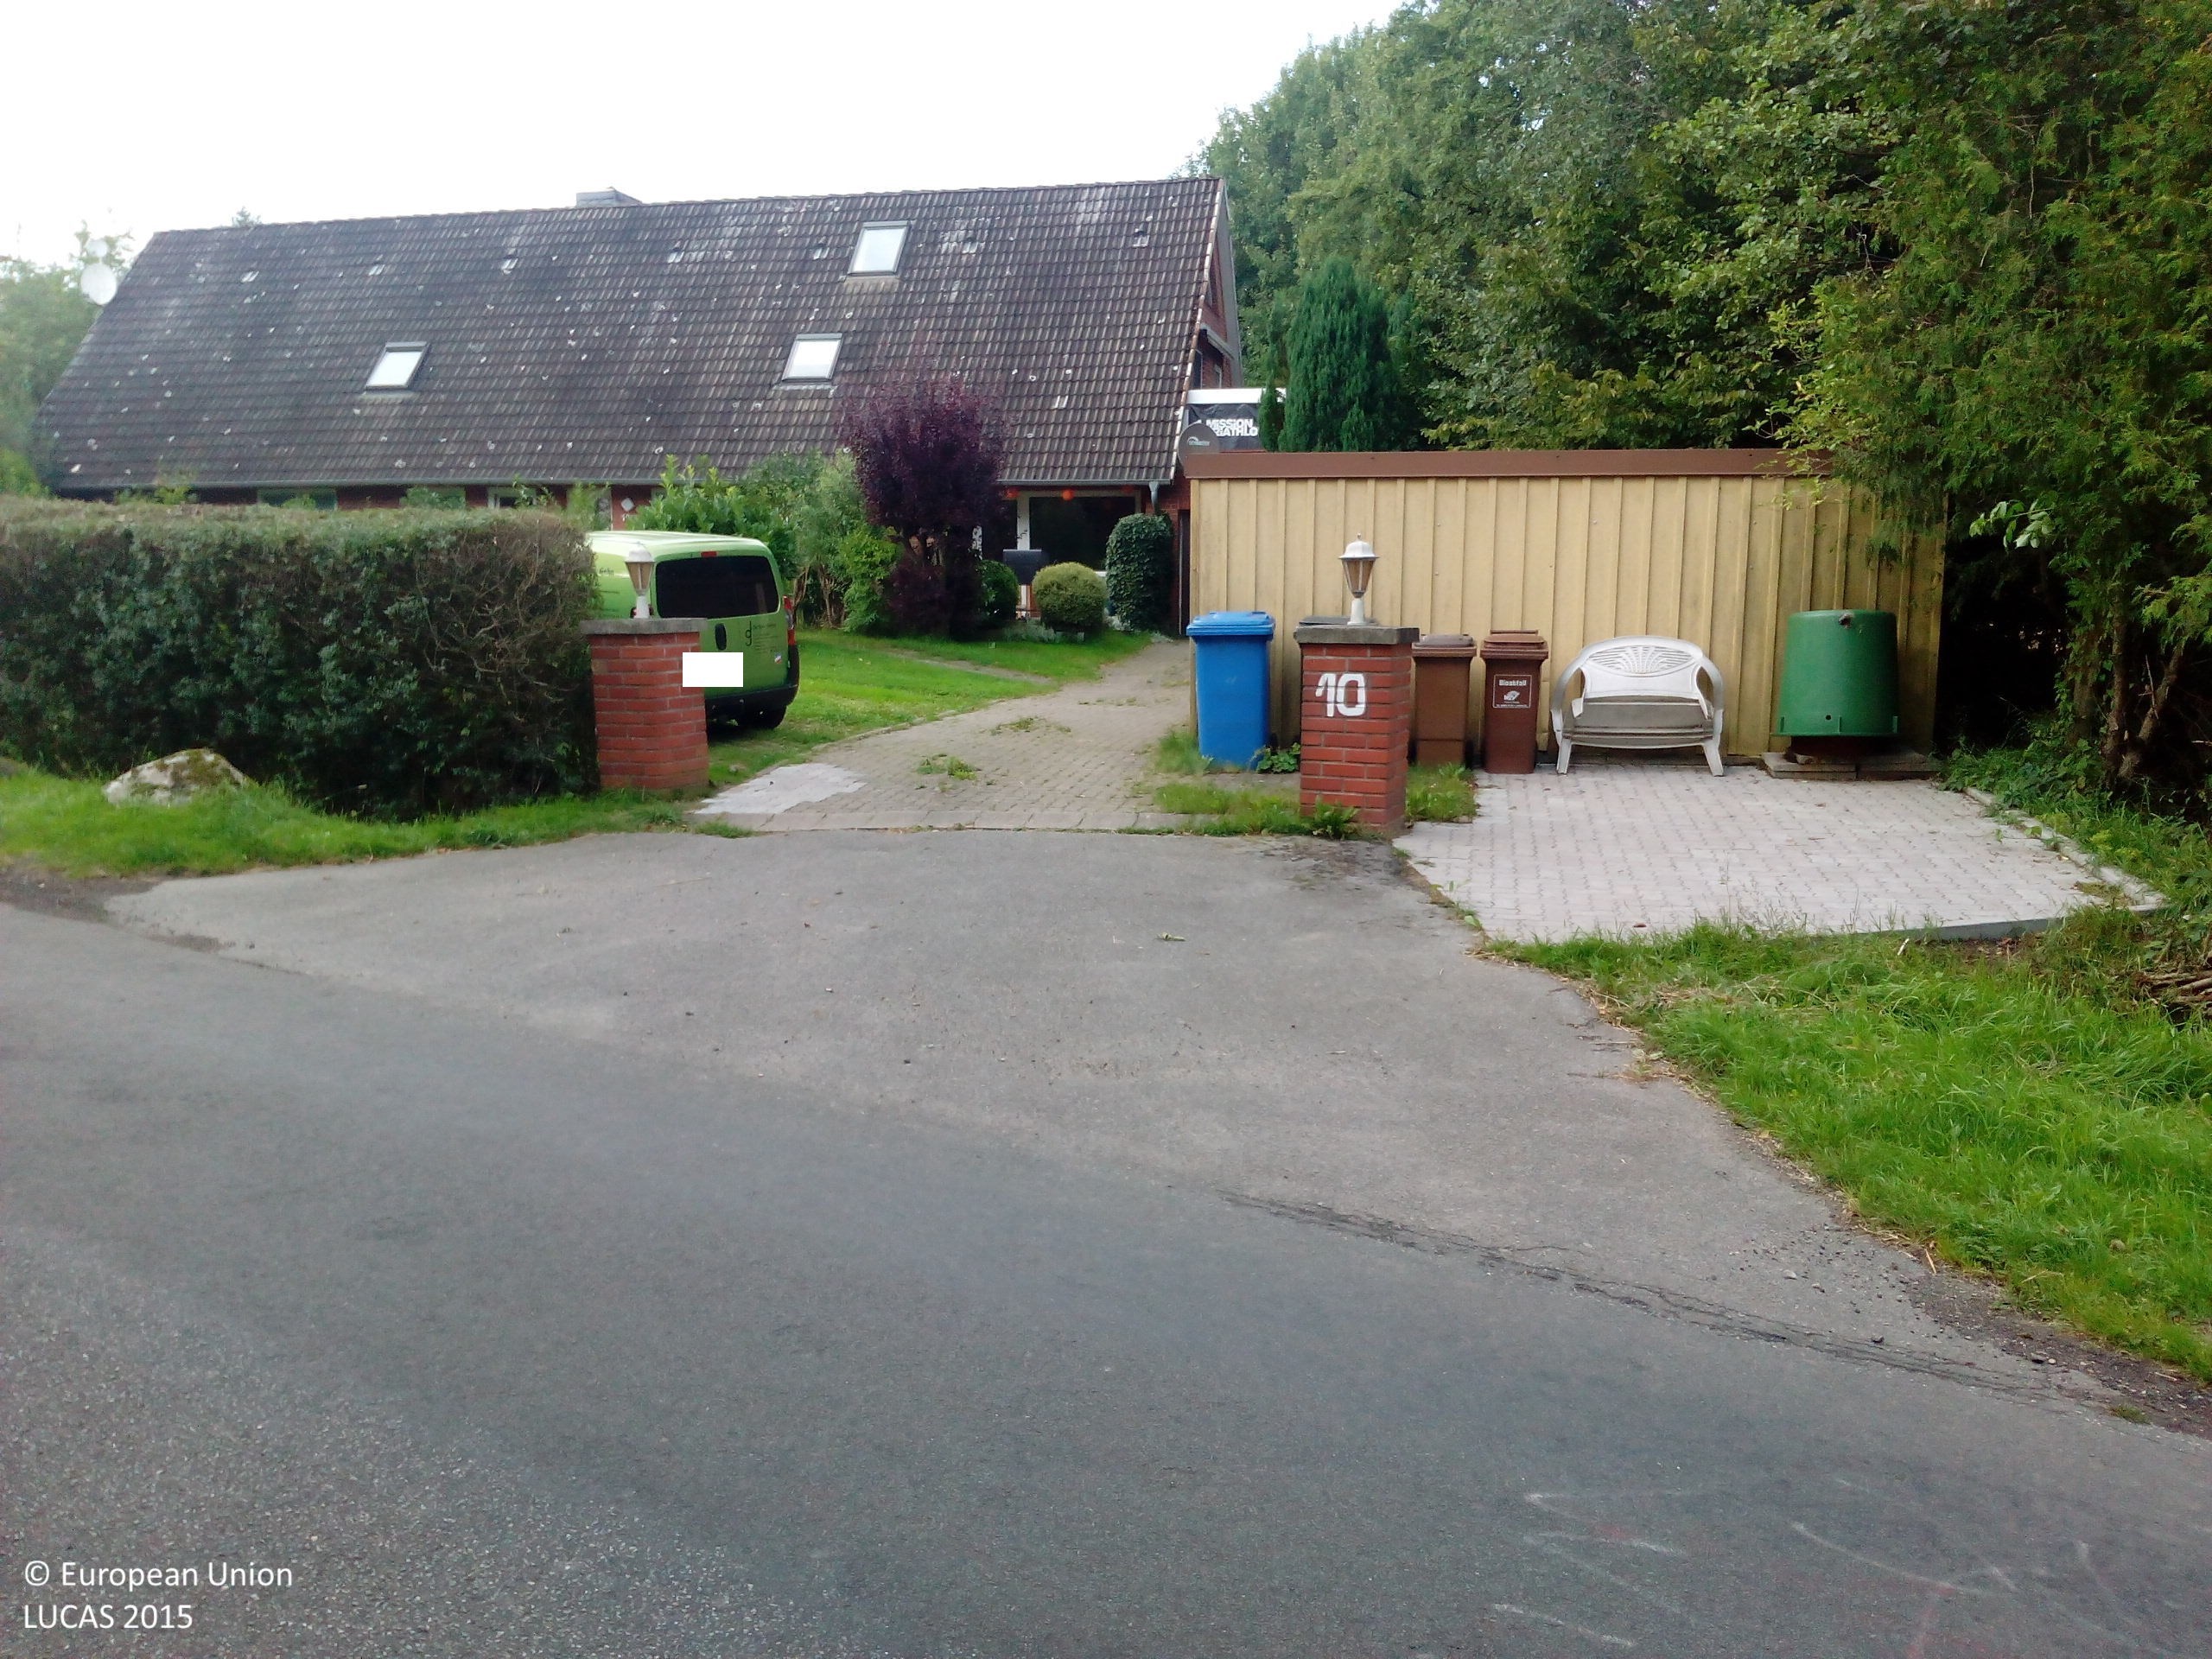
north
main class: Woodland
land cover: Broadleaved woodland
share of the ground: > 75 %
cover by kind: broadleaved forest trees 100 %
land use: Road transport
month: August
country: DE
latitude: 53.7973
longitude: 9.9545
